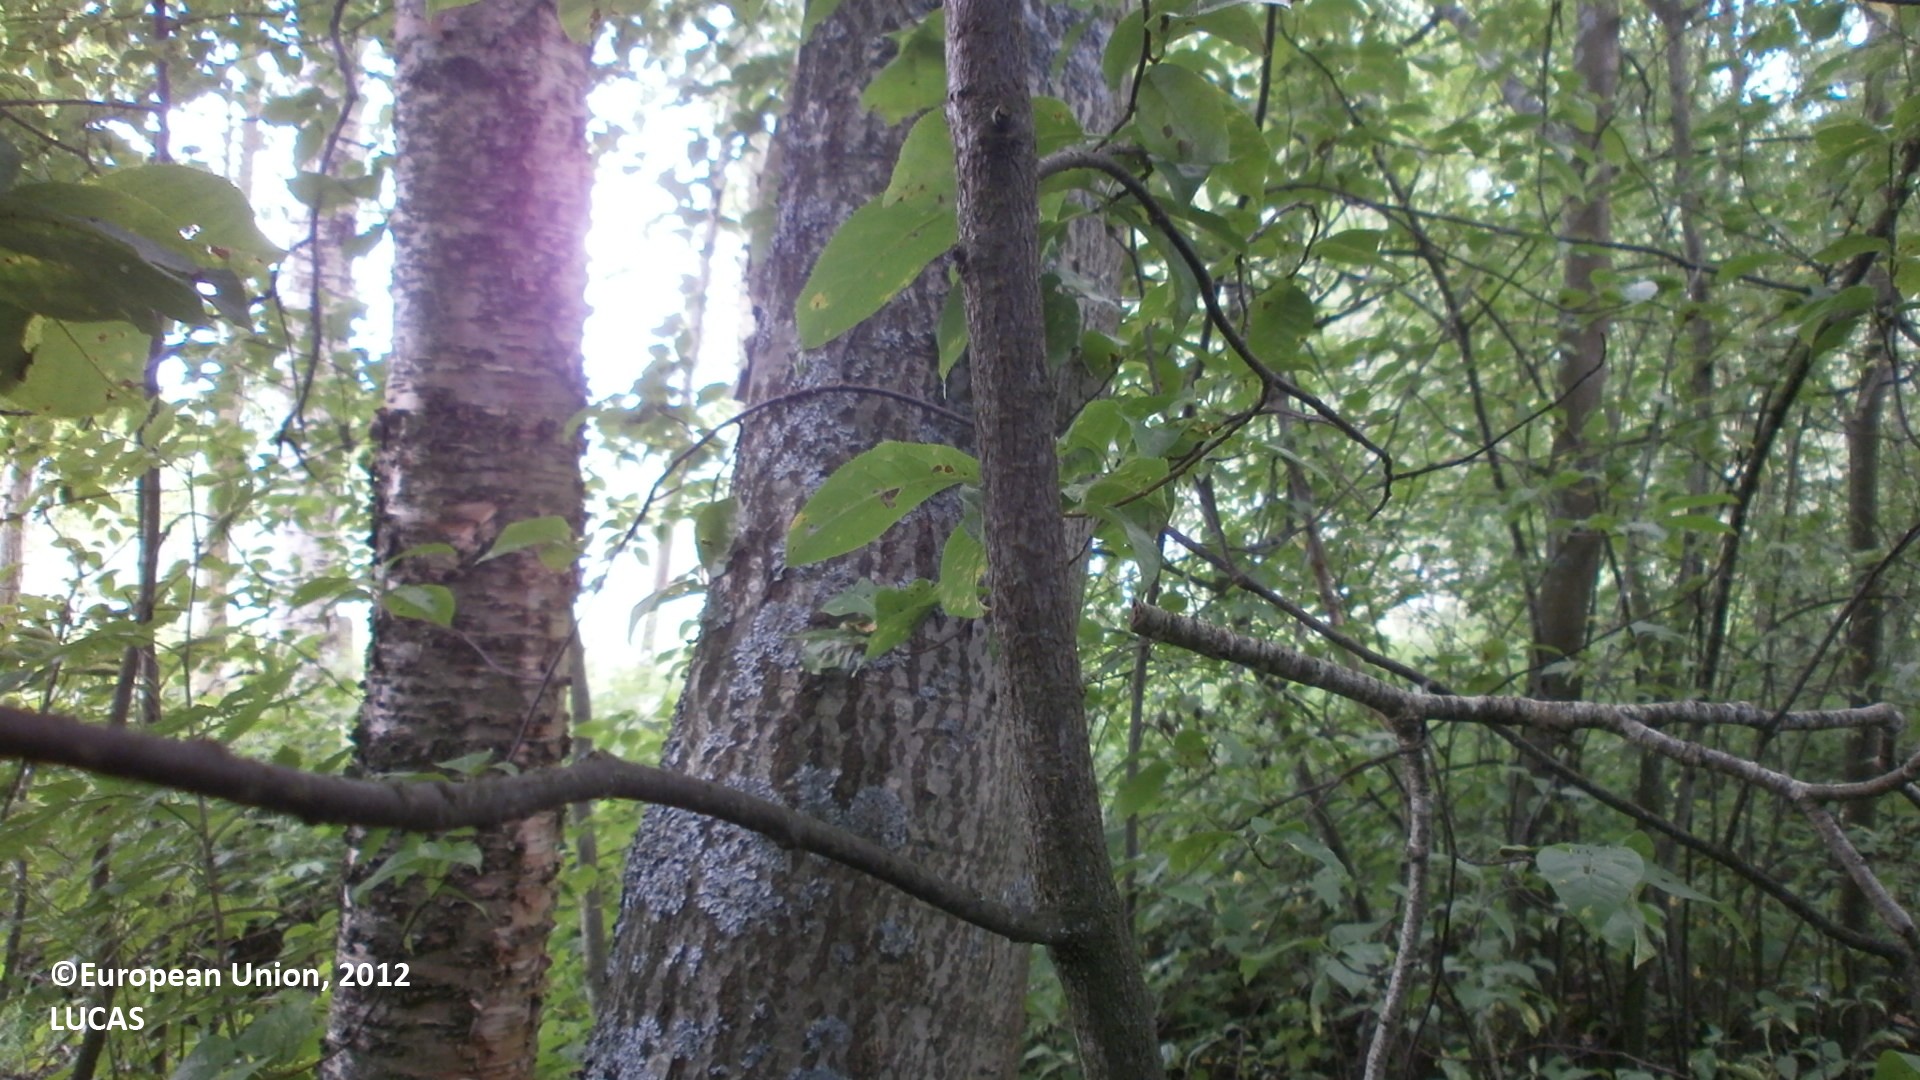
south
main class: Woodland
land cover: Broadleaved woodland
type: boreal forest
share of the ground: > 75 %
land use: Forestry
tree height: > 5 m
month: July
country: FI
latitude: 64.1323
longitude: 24.3058
